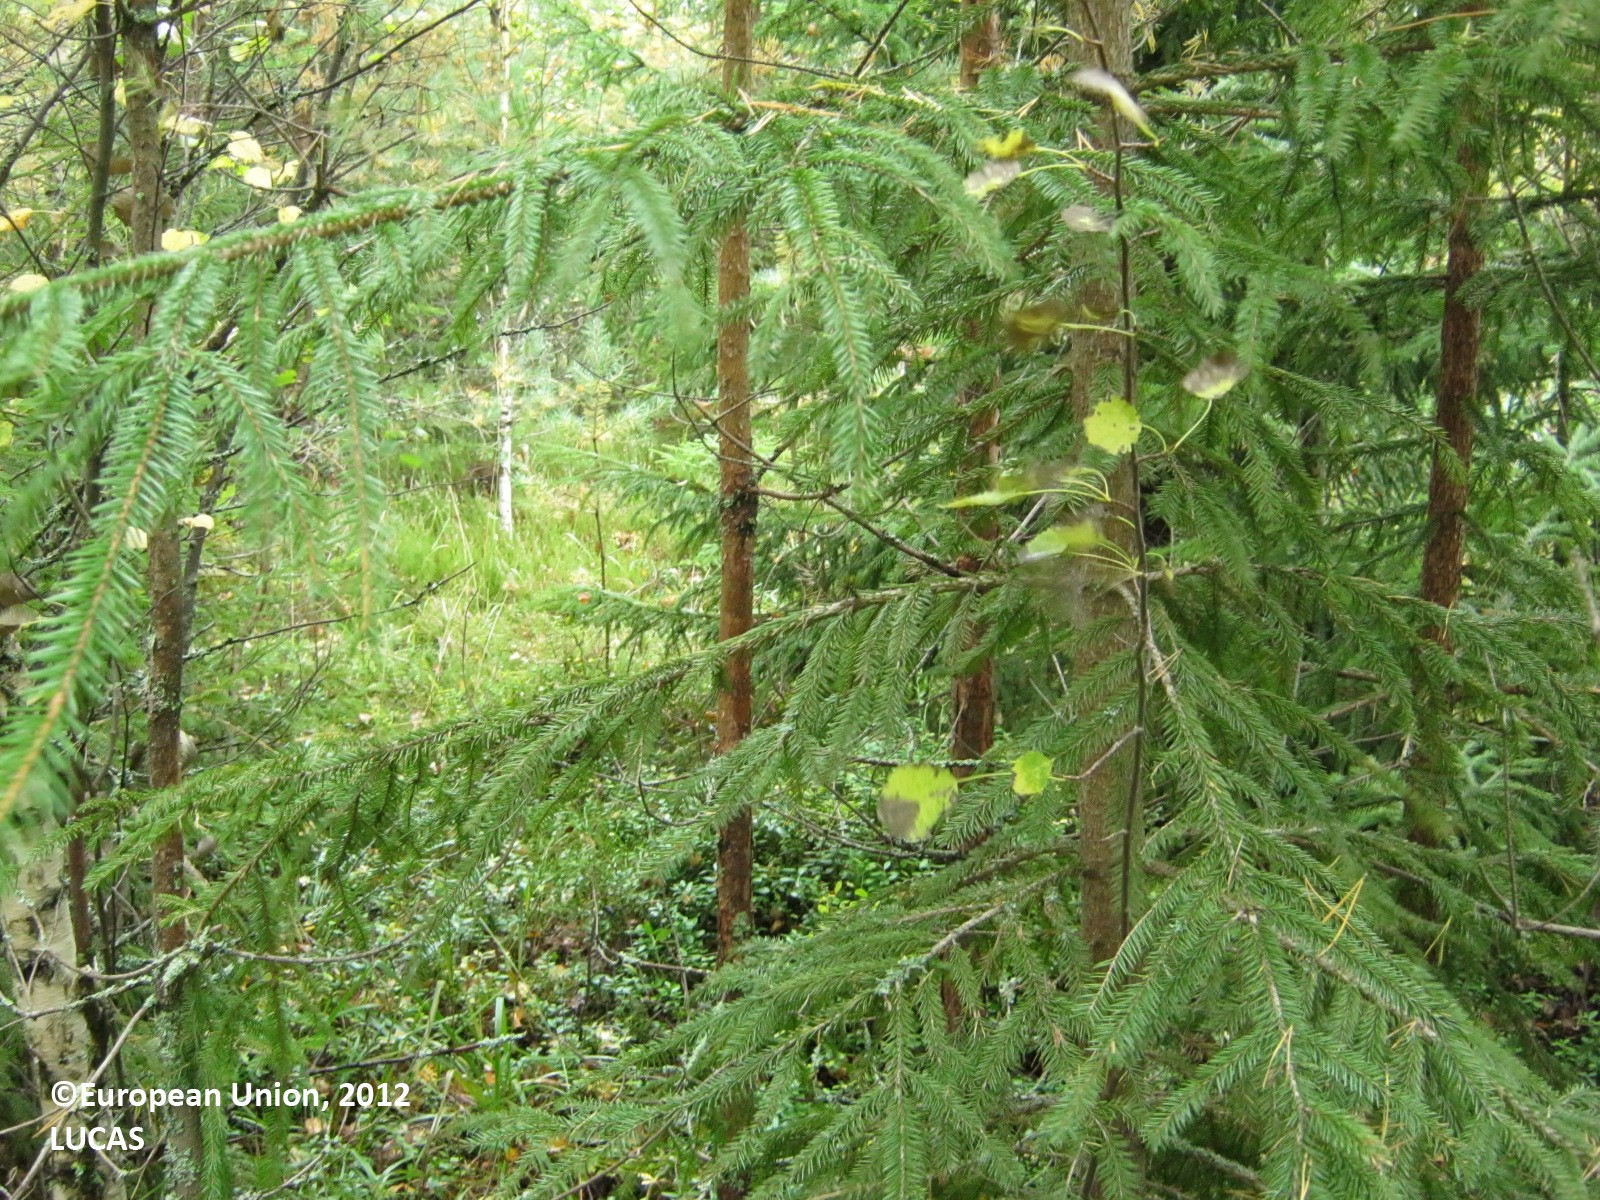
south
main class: Woodland
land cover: Spruce dominated mixed woodland
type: boreal forest
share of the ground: > 75 %
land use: Forestry
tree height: > 5 m
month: September
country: FI
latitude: 60.5716
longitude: 27.8032
